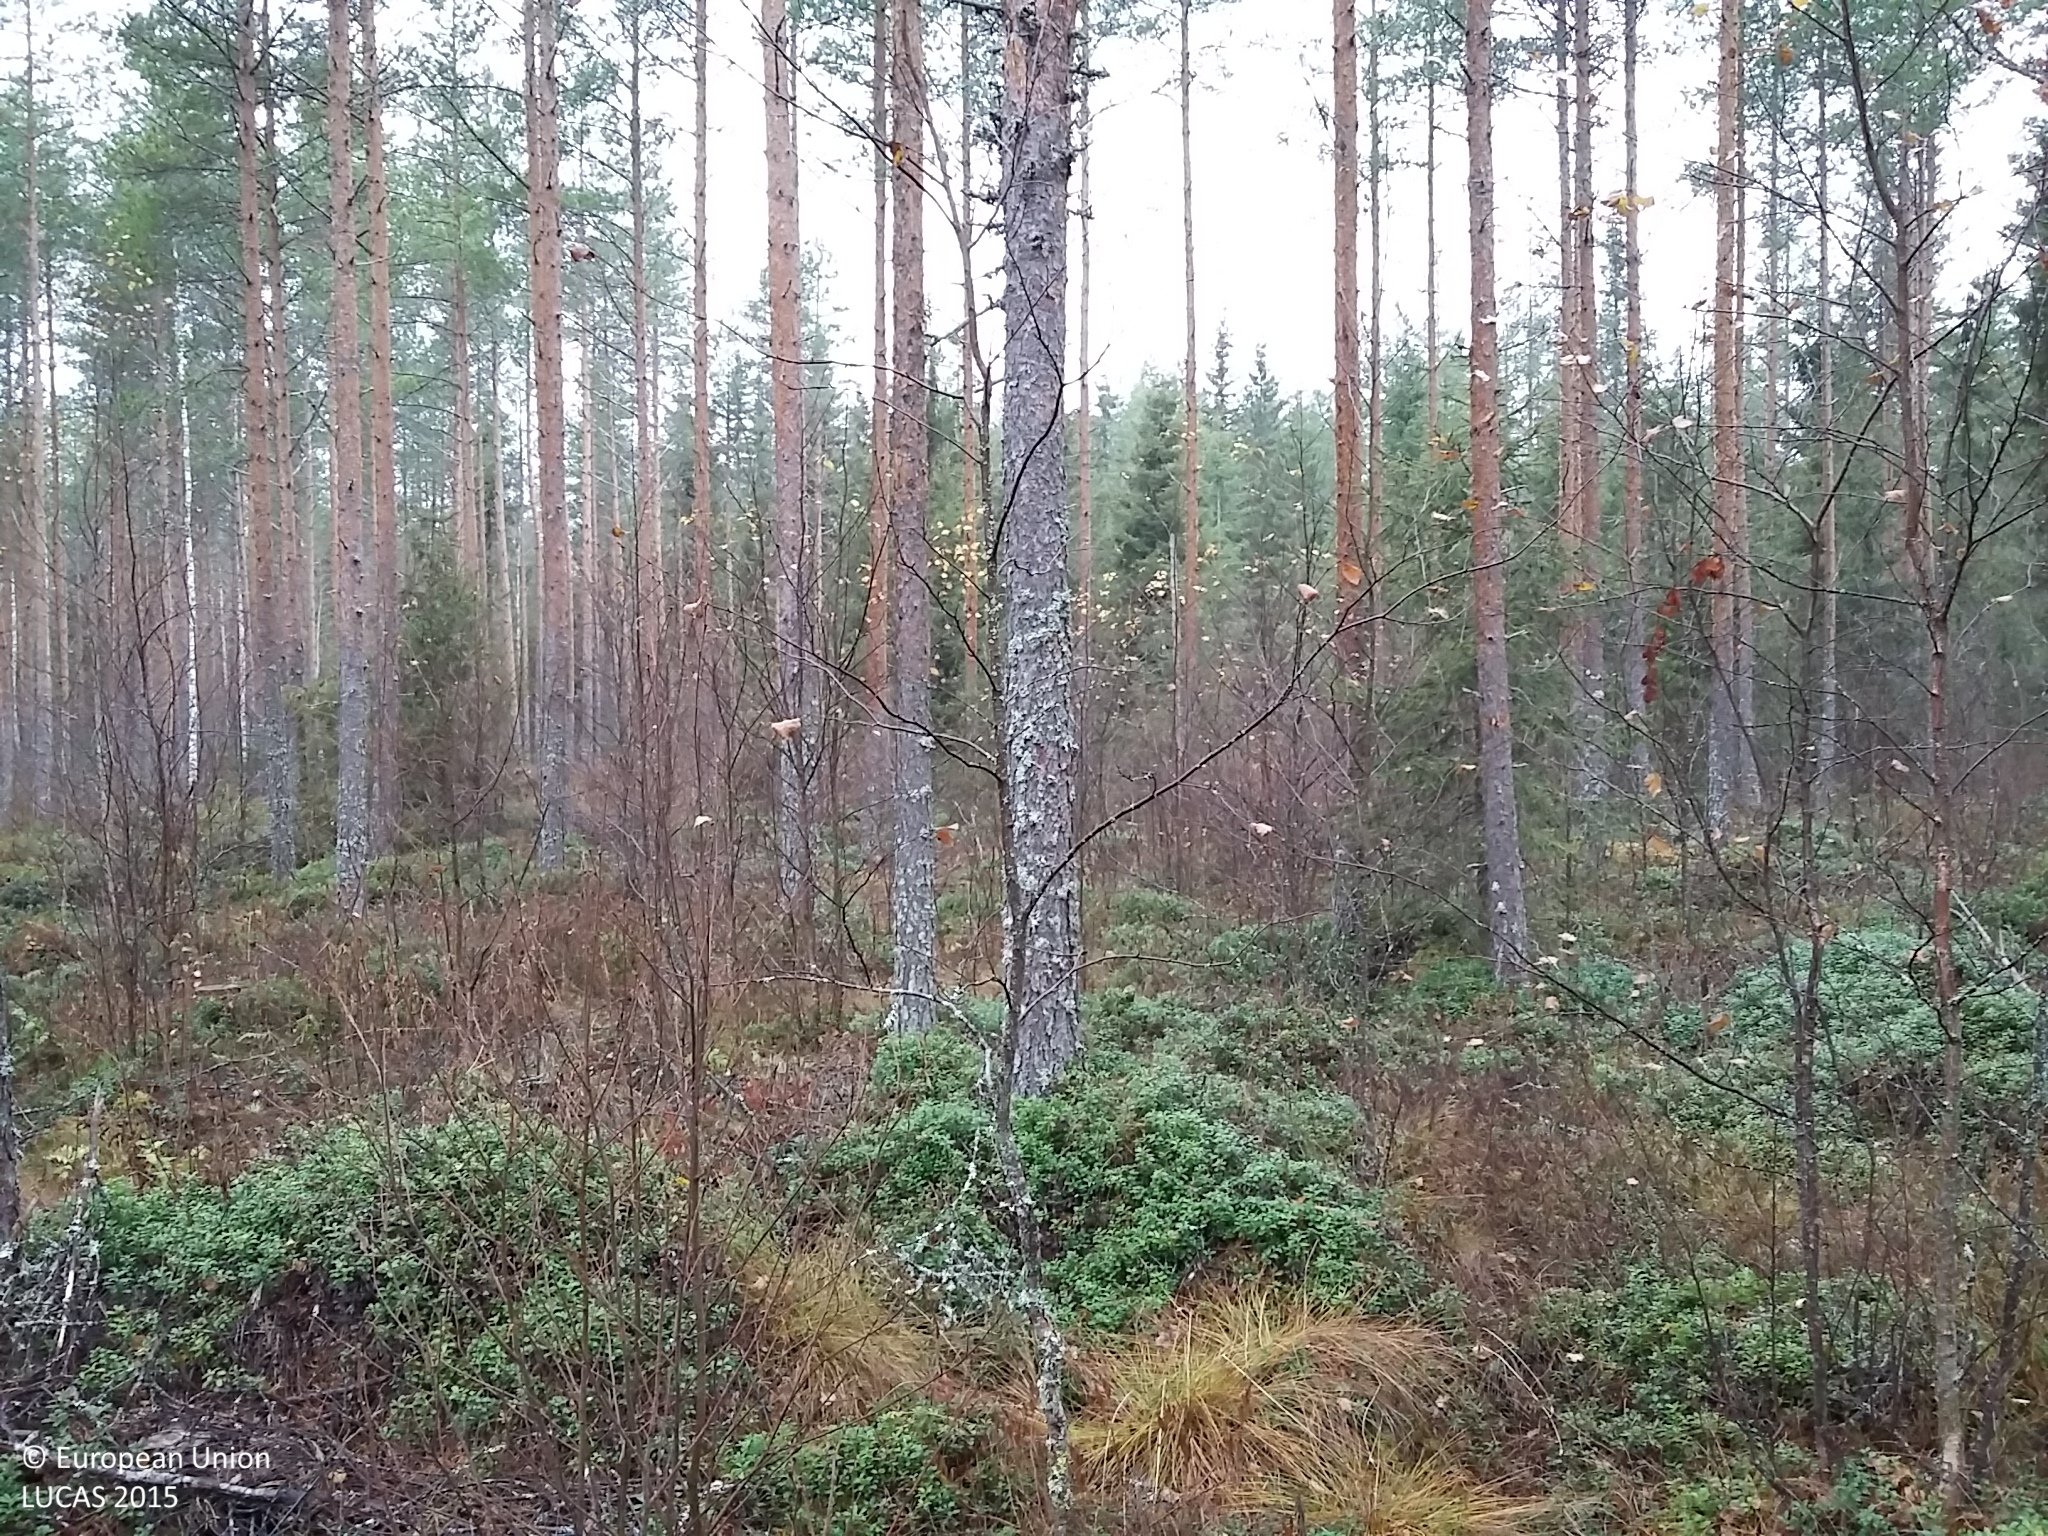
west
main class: Woodland
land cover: Pine dominated coniferous woodland
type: boreal forest
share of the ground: 50 - 75 %
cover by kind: coniferous forest trees 70 %, shrubs 20 %, lichens and mosses 10 %
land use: Forestry
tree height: > 5 m
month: October
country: FI
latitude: 64.3999
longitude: 25.3757
